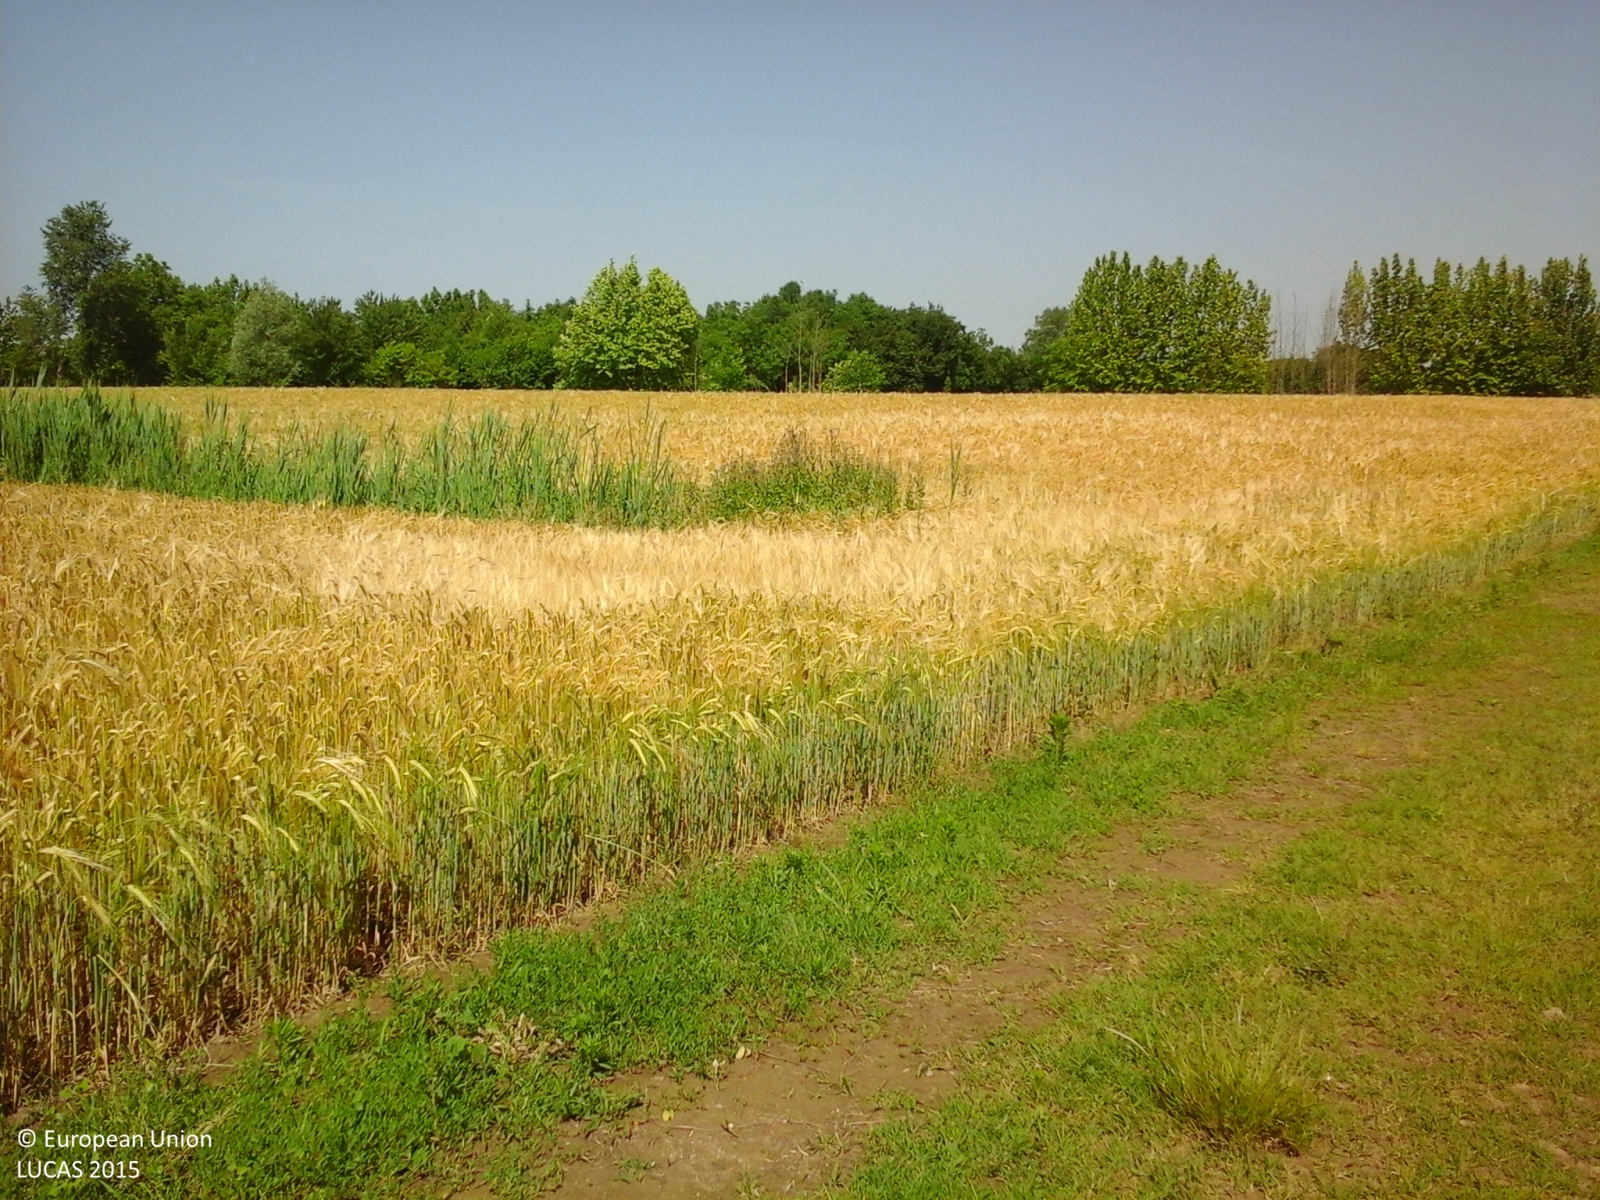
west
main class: Shrubland
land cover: Shrubland with sparse tree cover
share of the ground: > 75 %
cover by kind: shrubs 65 %, herbaceous plants 30 %, broadleaved forest trees 5 %
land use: Semi-natural and natural areas not in use
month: May
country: IT
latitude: 45.1398
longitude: 10.9266
